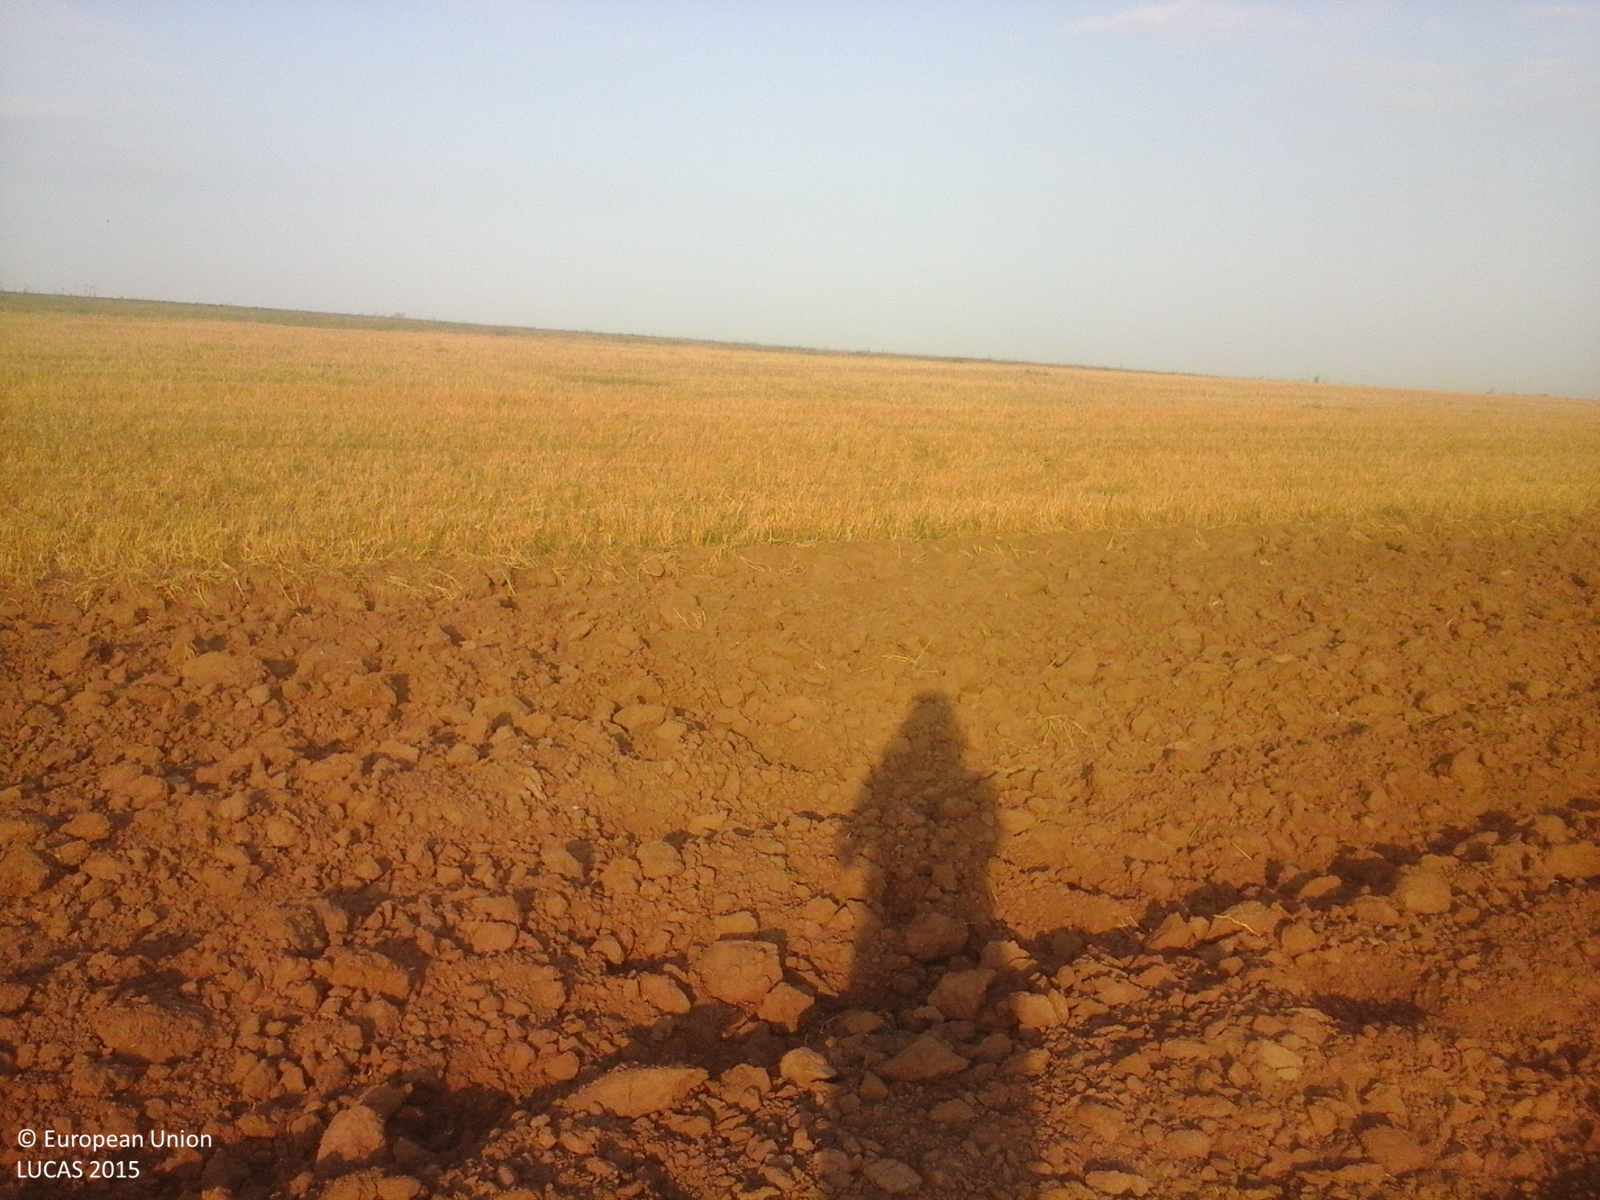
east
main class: Cropland
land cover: Common wheat
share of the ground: < 10 %
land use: Agriculture (excluding fallow land and kitchen gardens)
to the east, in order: Common wheat; Lucerne; Other bare soil
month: August
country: RO
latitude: 43.9665
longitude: 28.0640
